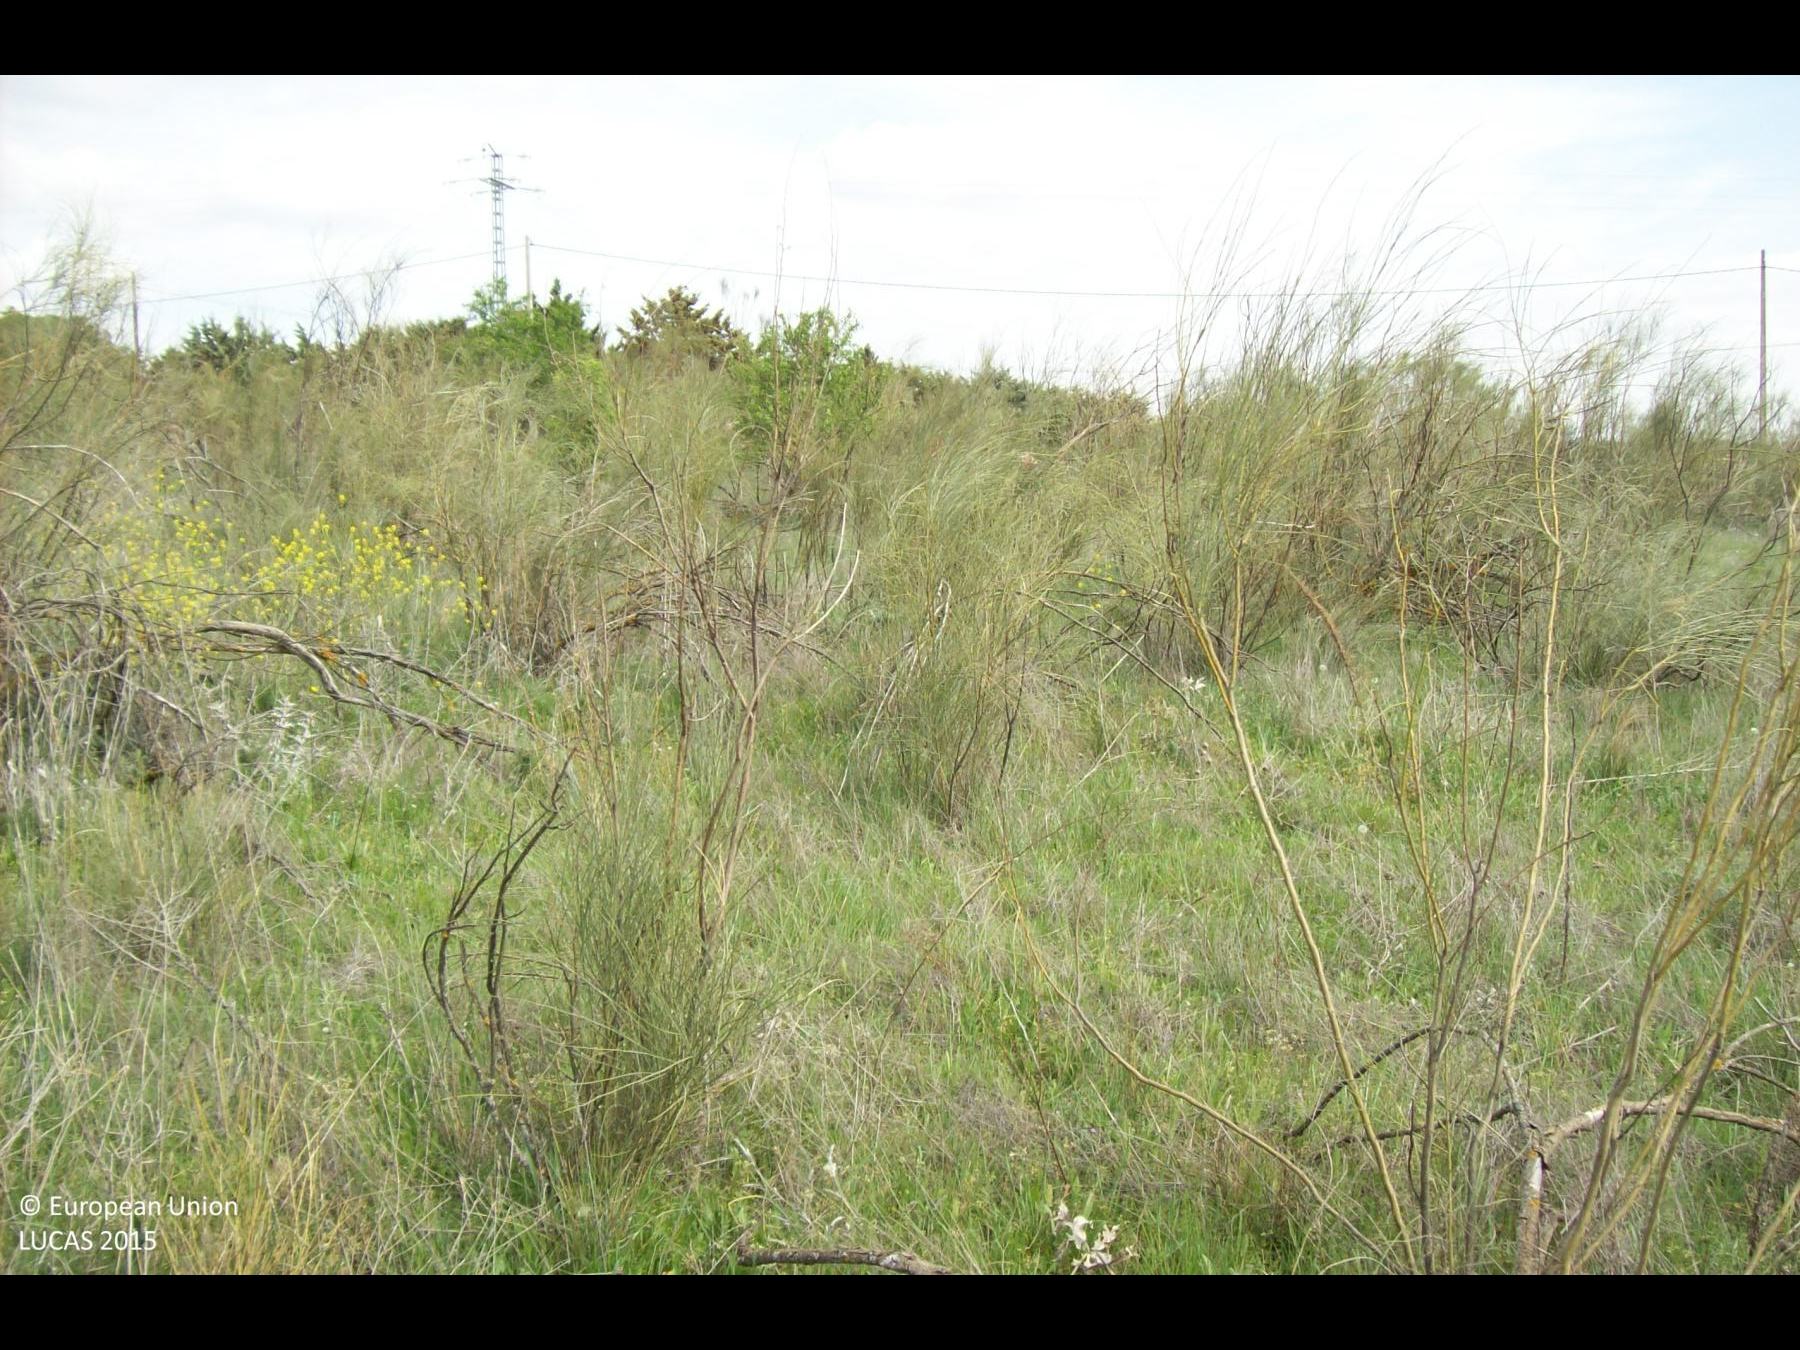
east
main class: Shrubland
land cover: Shrubland without tree cover
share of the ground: > 75 %
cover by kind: shrubs 50 %, herbaceous plants 50 %
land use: Semi-natural and natural areas not in use
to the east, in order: Shrubland without tree cover; Grassland without tree/shrub cover; Other bare soil; Grass margins; Electric lines; Tracks; Electric lines; Artificial constructions in urban areas; Electric lines; Fences; Barley; Single bushes/trees; Grass margins; Spontaneously vegetated surfaces
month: April
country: ES
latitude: 40.4784
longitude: -3.9252
